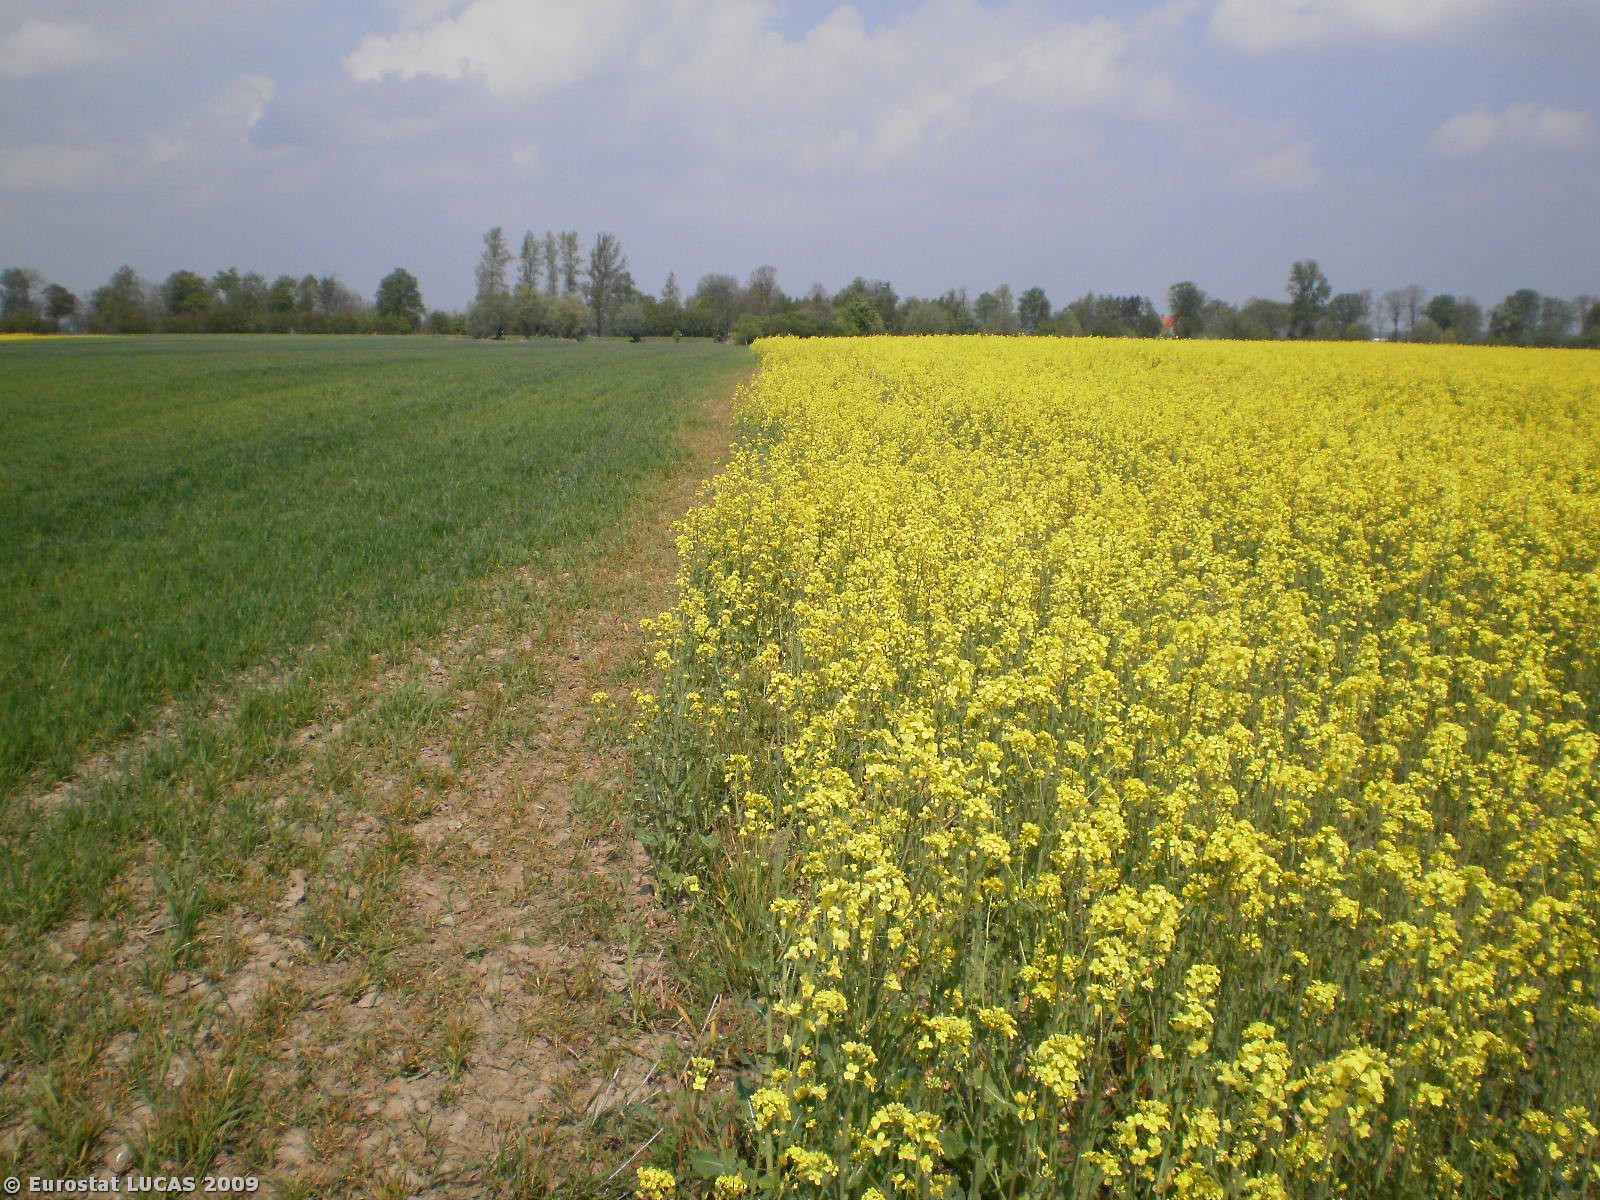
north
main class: Cropland
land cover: Rape and turnip rape
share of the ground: > 75 %
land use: Agriculture (excluding fallow land and kitchen gardens)
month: May
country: PL
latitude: 54.2981
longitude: 18.9792
